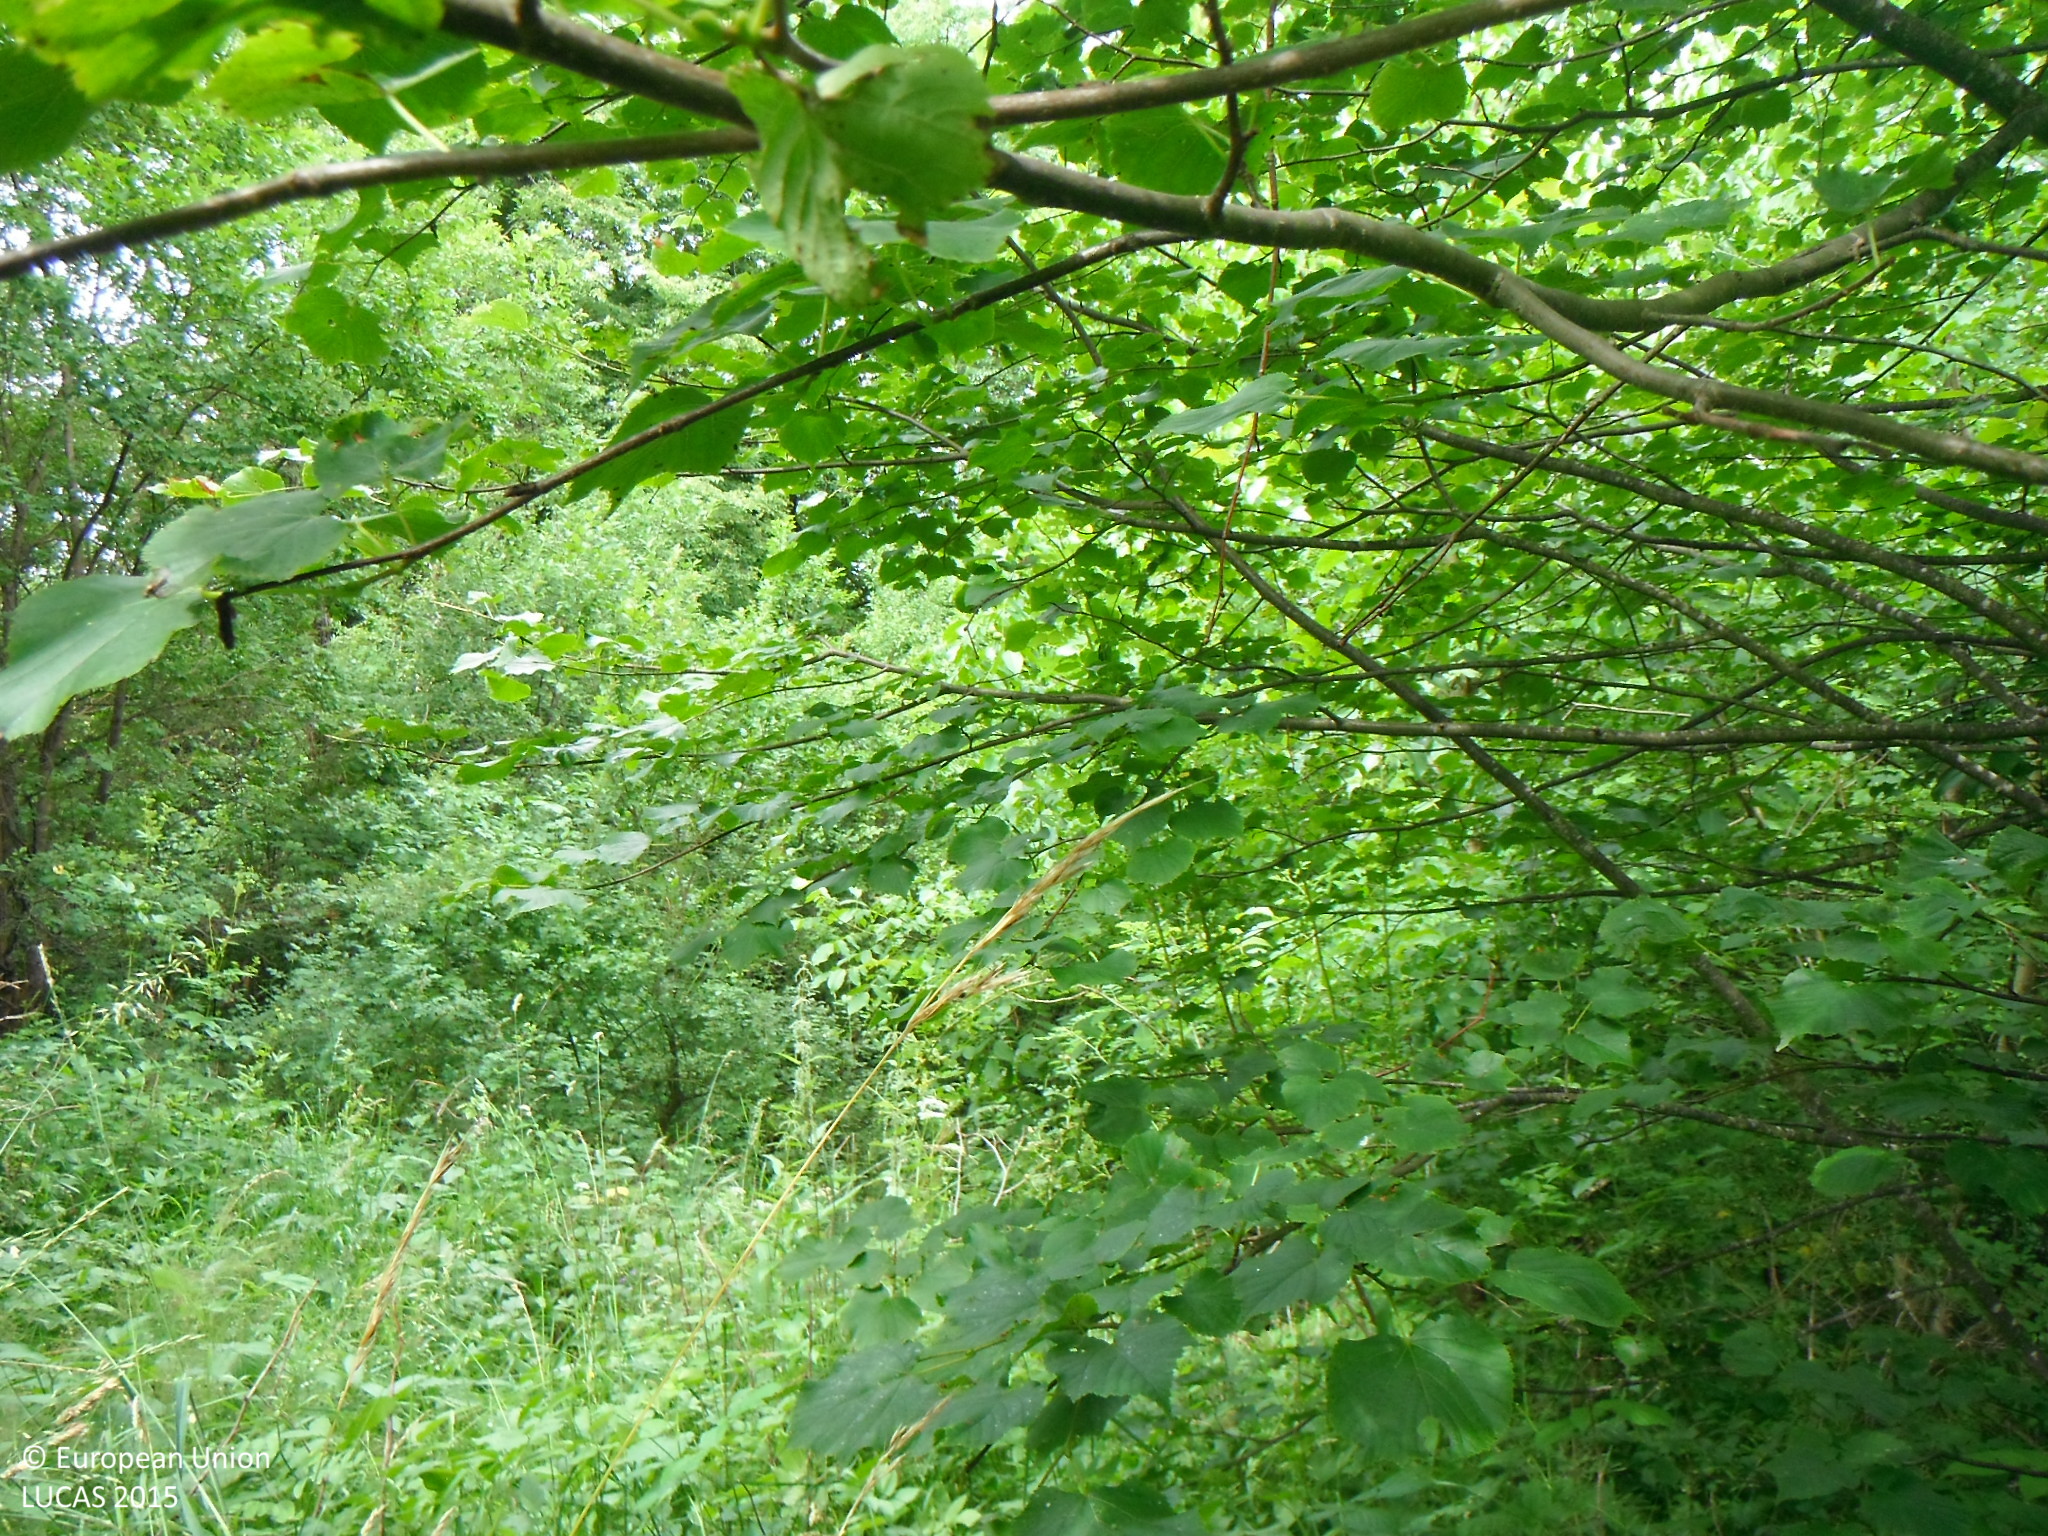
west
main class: Woodland
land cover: Broadleaved woodland
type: mesophytic deciduous forest
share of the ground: 25 - 50 %
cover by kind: broadleaved forest trees 60 %, herbaceous plants 30 %, shrubs 10 %
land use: Forestry
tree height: > 5 m
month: June
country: SK
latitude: 48.6780
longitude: 19.9576
